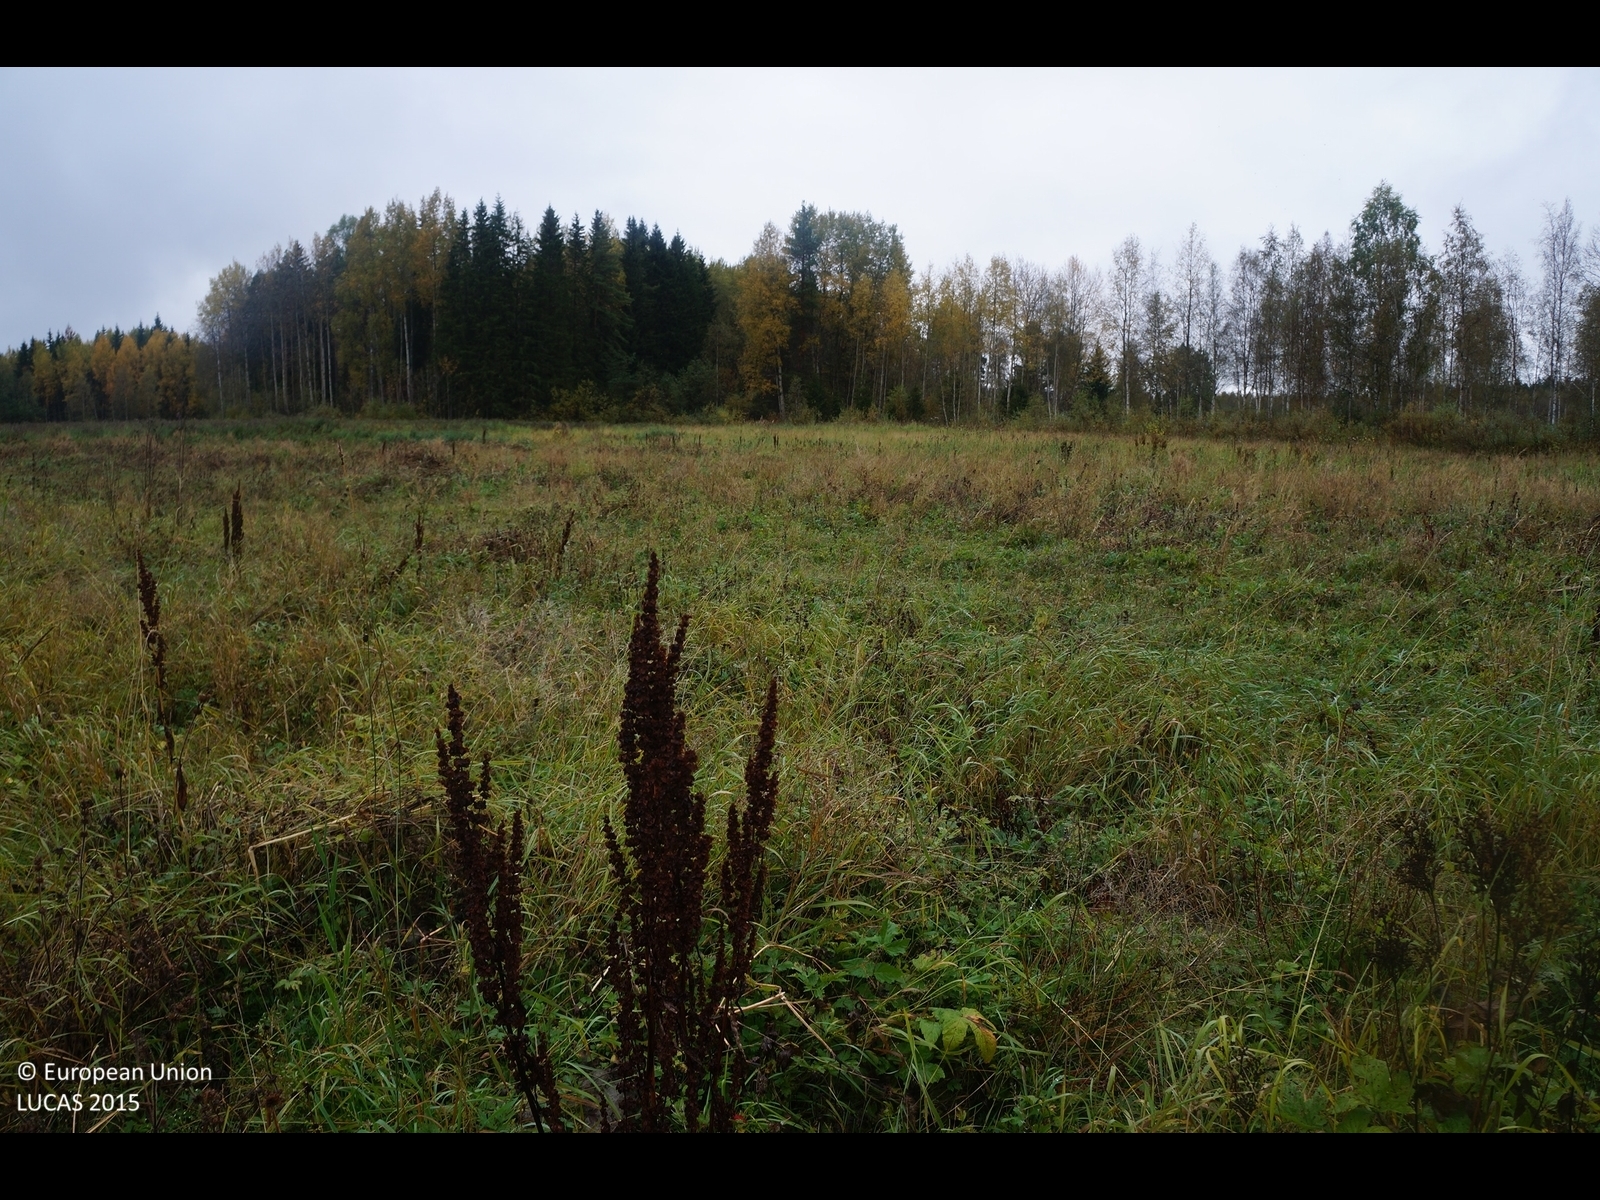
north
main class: Grassland
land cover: Spontaneously vegetated surfaces
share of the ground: > 75 %
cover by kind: herbaceous plants 100 %
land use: Fallow land
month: September
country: FI
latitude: 64.0824
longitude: 24.4476
